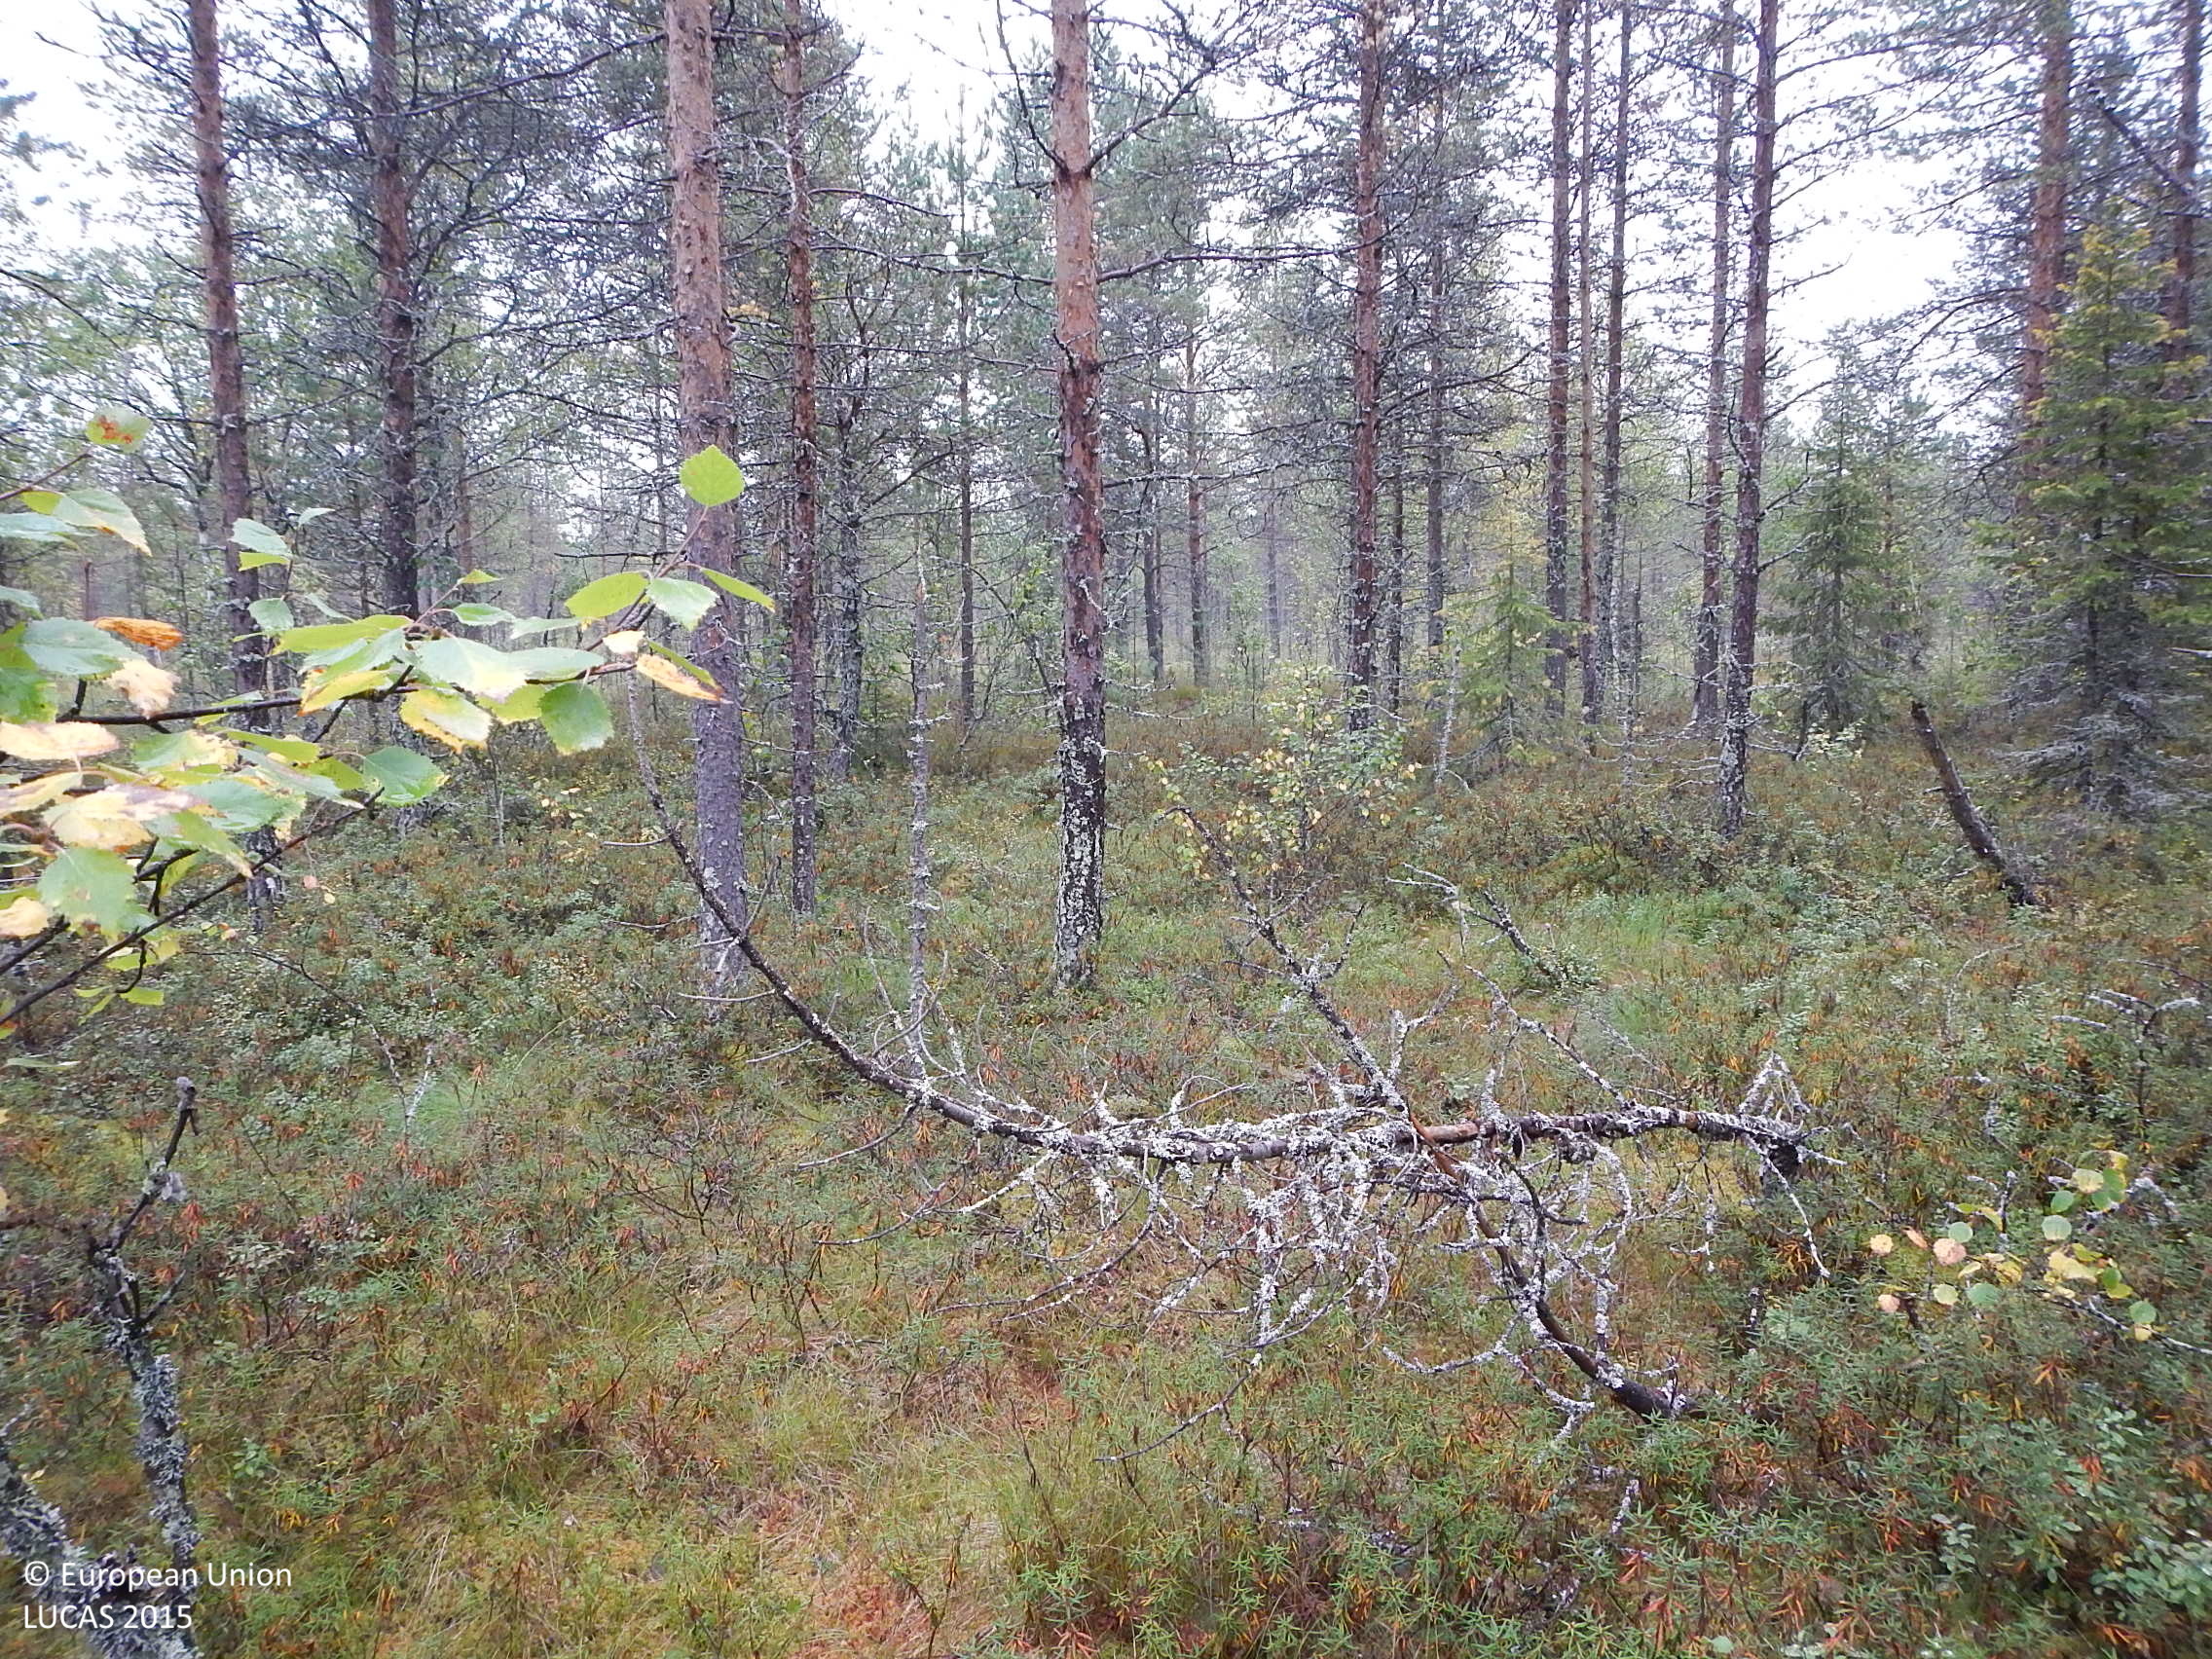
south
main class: Woodland
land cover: Pine dominated coniferous woodland
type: mire and swamp forests
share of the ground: > 75 %
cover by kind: coniferous forest trees 70 %, shrubs 15 %, broadleaved forest trees 10 %, lichens and mosses 5 %
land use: Forestry
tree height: > 5 m
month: August
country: FI
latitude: 65.8414
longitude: 27.2631
